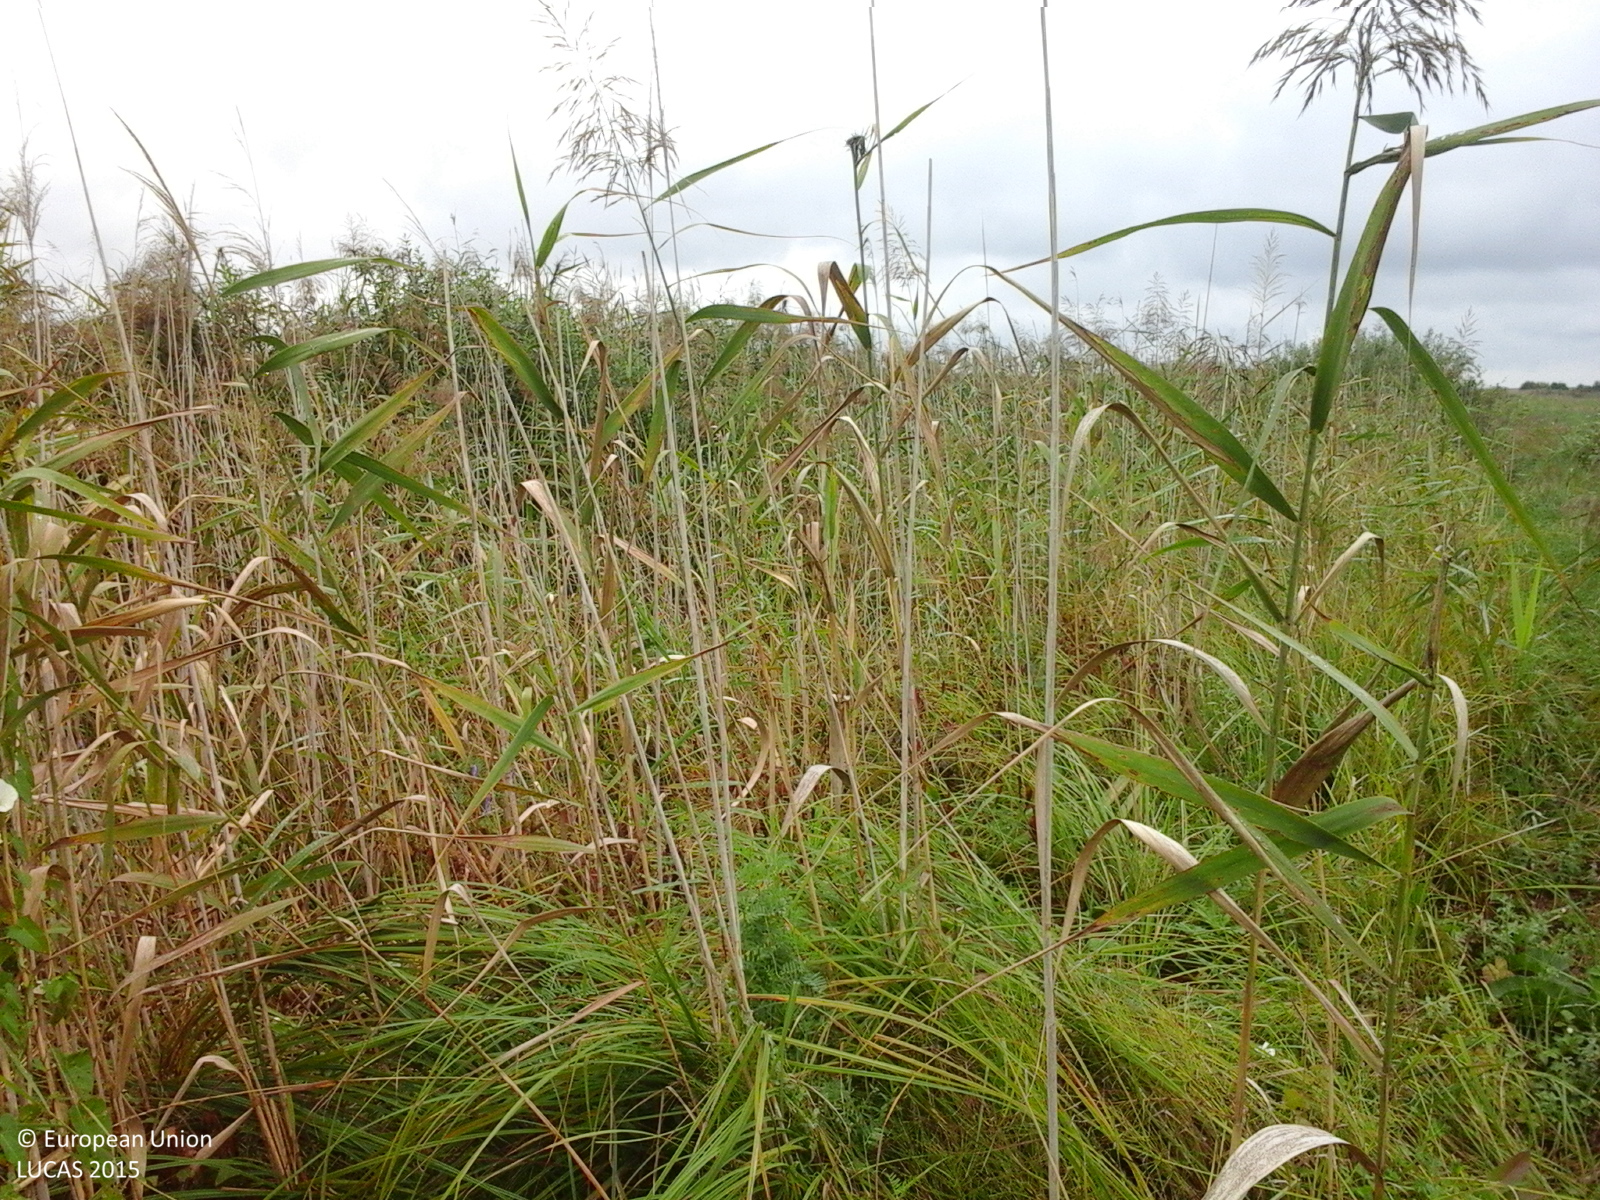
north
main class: Grassland
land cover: Spontaneously vegetated surfaces
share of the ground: > 75 %
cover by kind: herbaceous plants 100 %
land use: Fallow land
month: September
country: RO
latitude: 46.8645
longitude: 21.7574
